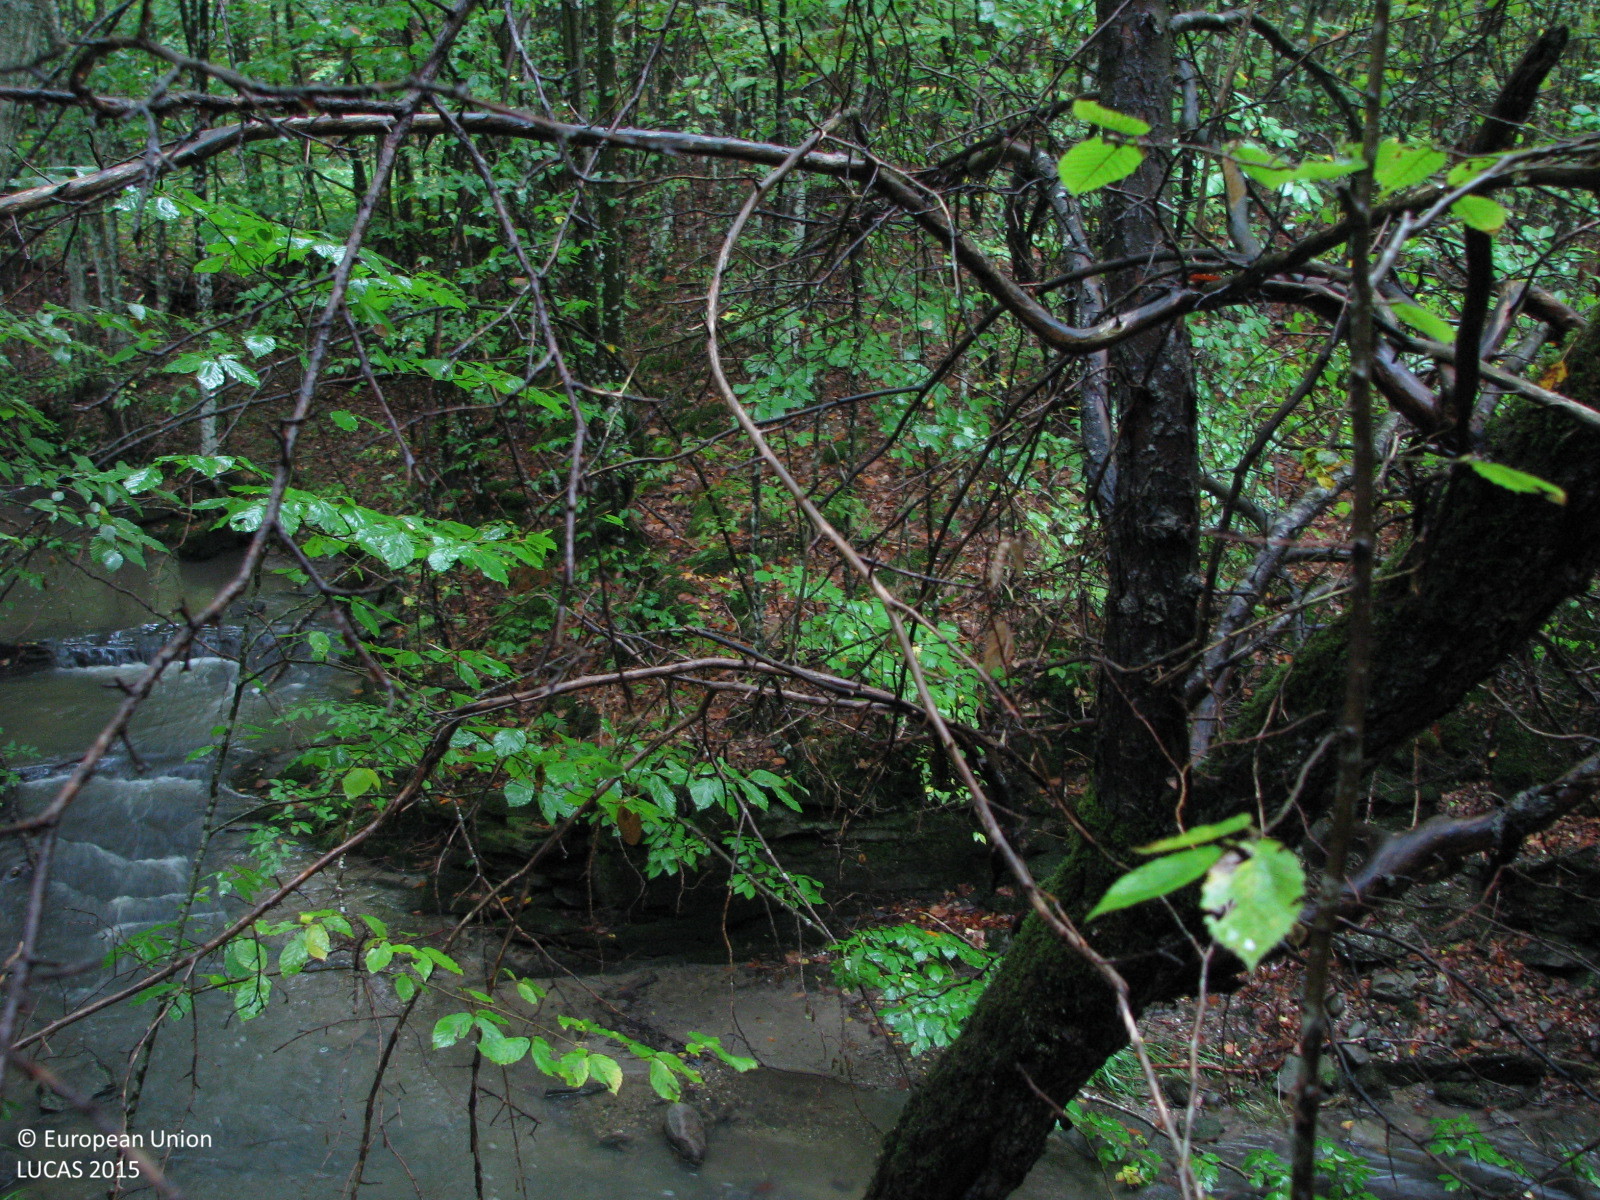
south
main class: Woodland
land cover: Broadleaved woodland
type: mesophytic deciduous forest
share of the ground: > 75 %
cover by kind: broadleaved forest trees 100 %
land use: Forestry
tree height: > 5 m
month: September
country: BG
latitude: 42.9282
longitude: 26.3784
